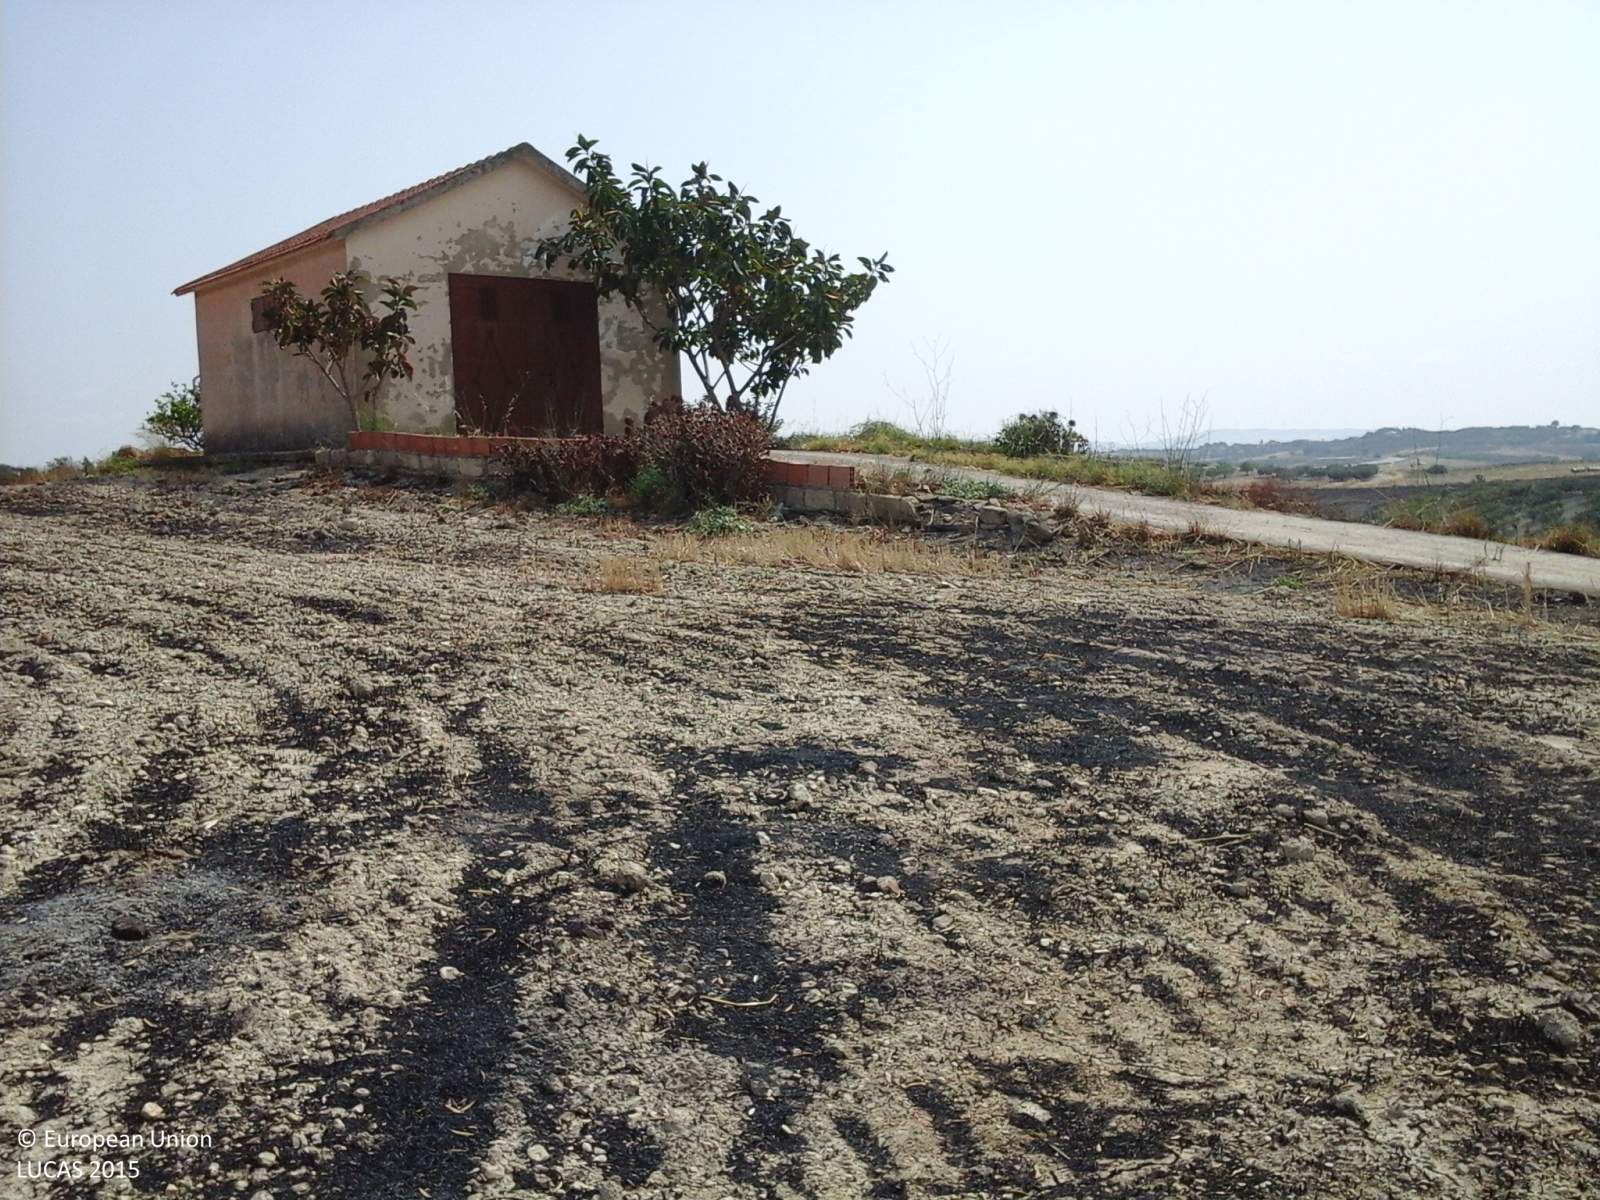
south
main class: Cropland
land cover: Durum wheat
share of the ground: > 75 %
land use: Agriculture (excluding fallow land and kitchen gardens)
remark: Burnt area
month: July
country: IT
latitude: 37.2475
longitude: 13.9489
